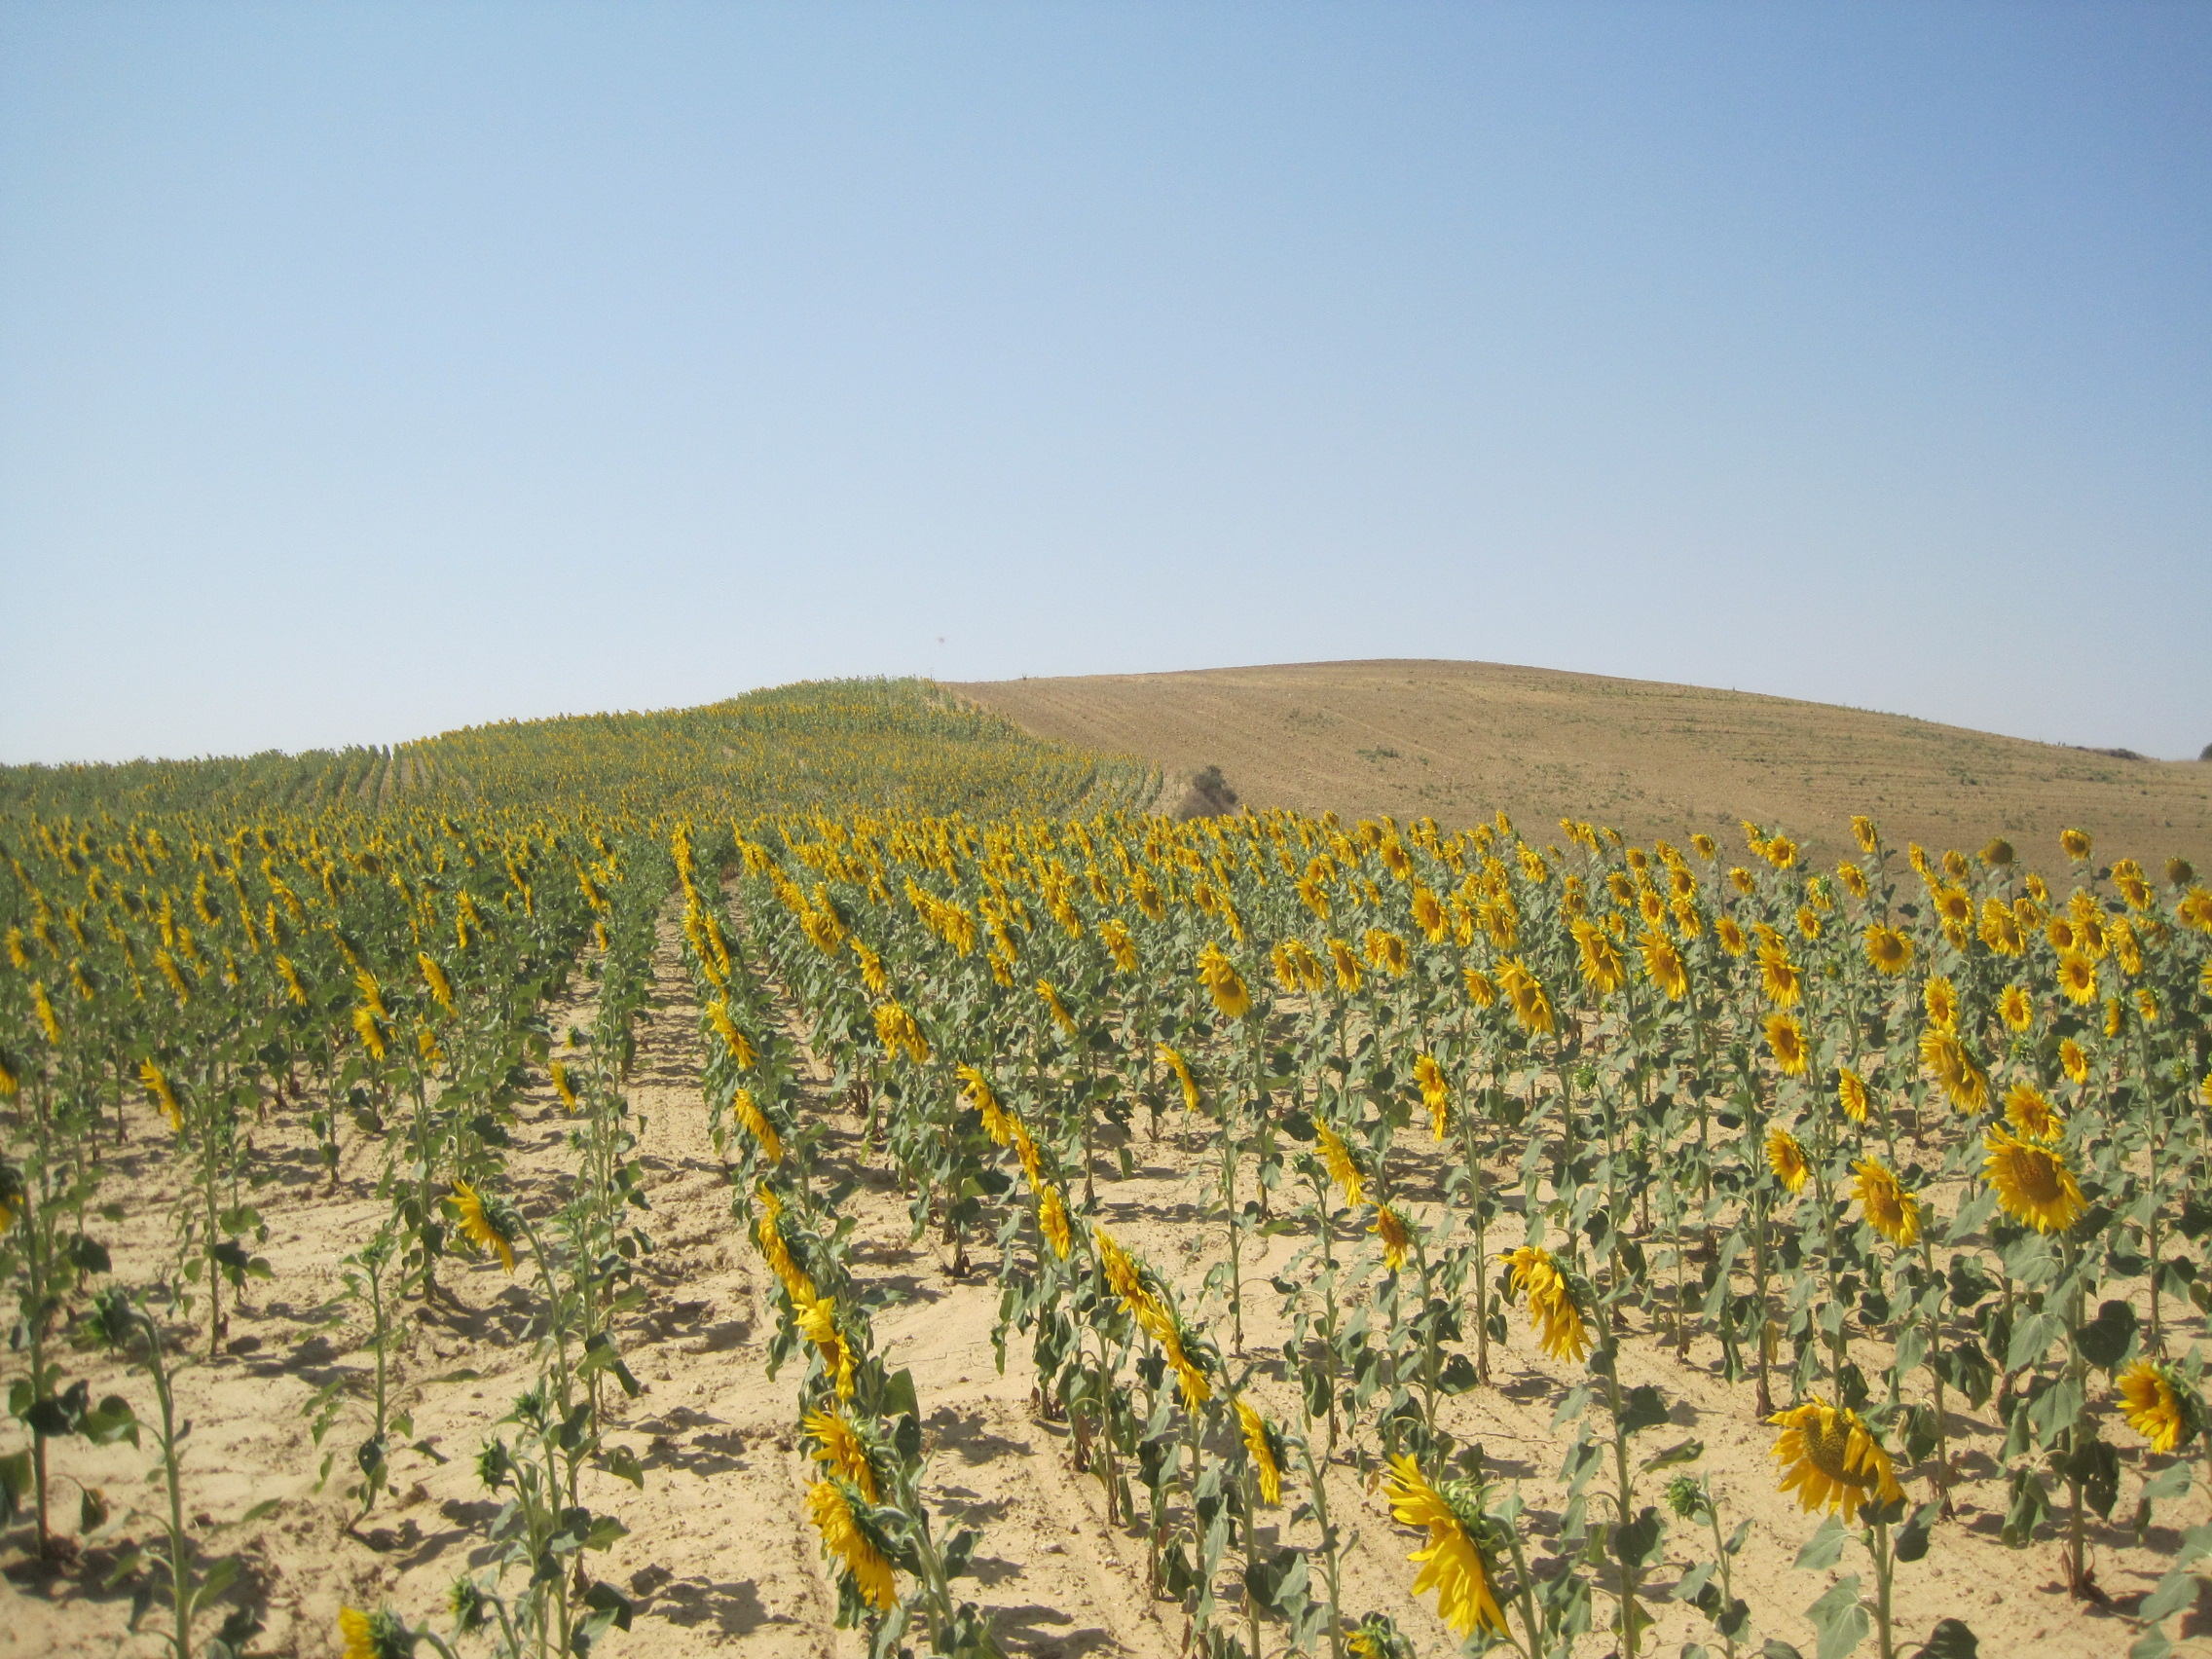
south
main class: Cropland
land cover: Sunflower
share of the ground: > 75 %
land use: Agriculture (excluding fallow land and kitchen gardens)
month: July
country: ES
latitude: 41.6493
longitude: -5.4149
